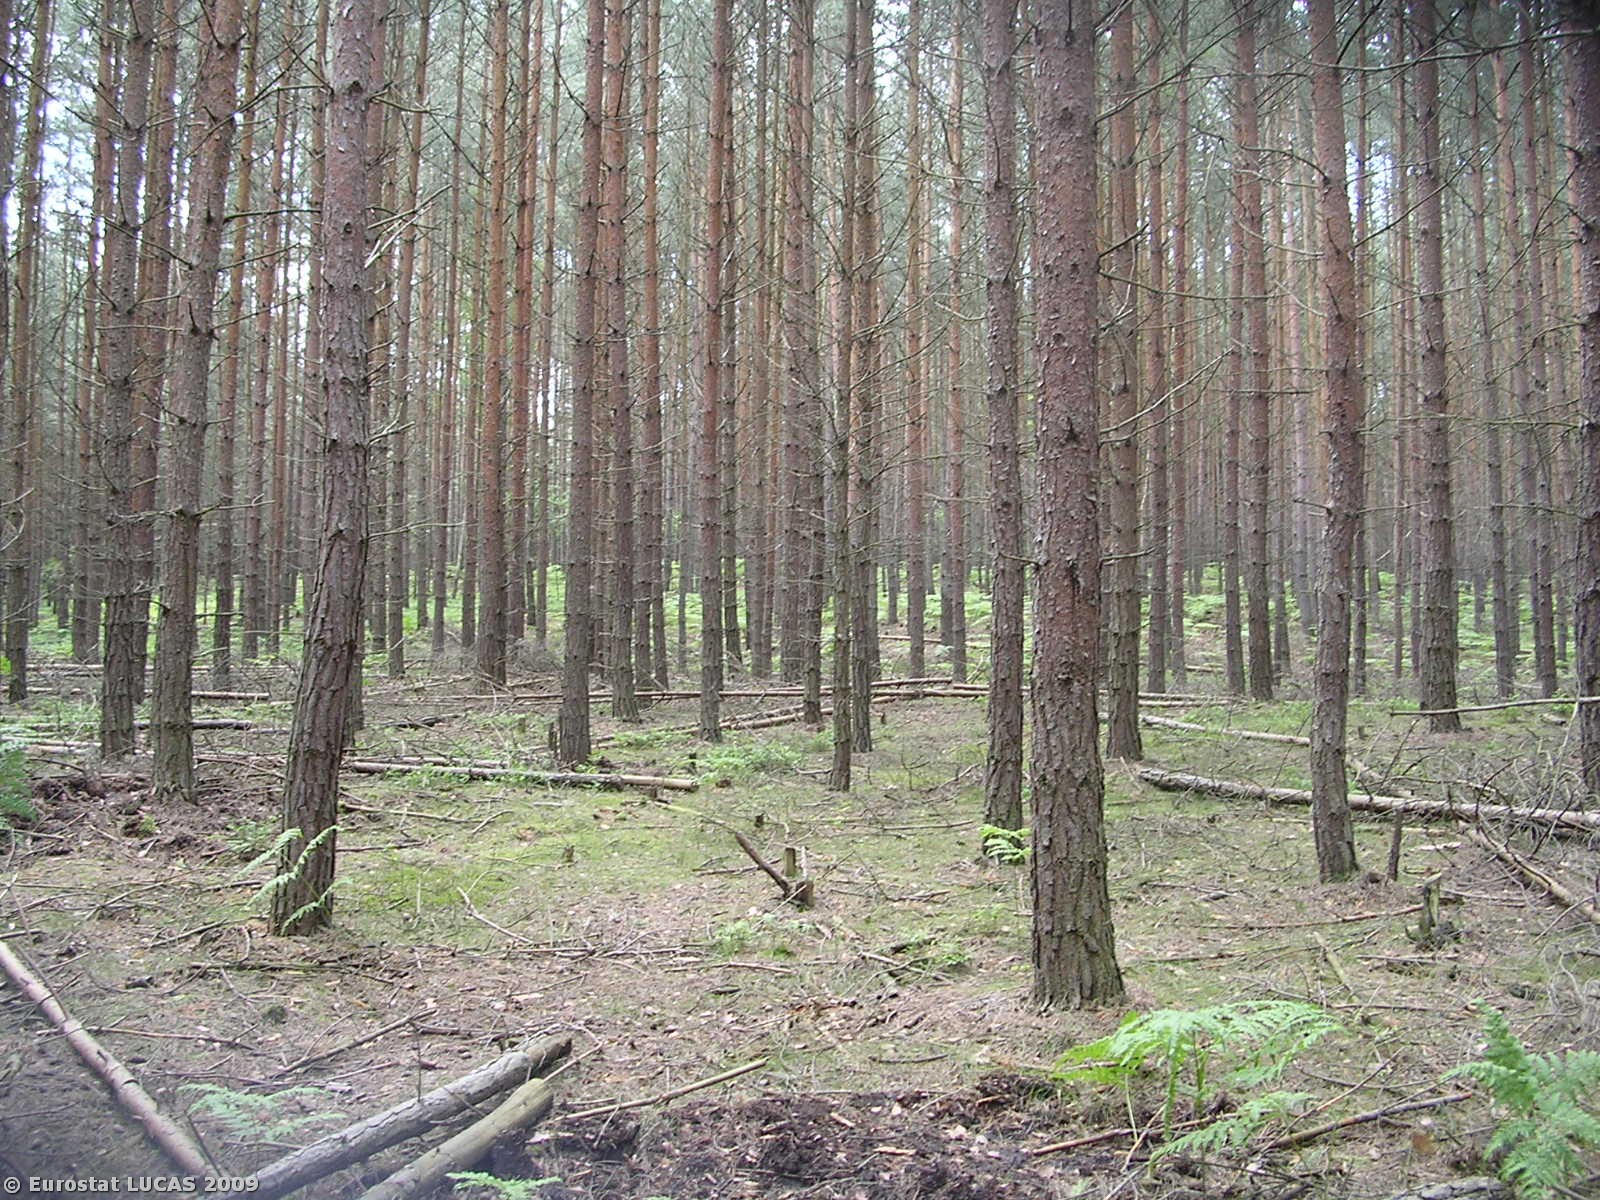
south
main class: Woodland
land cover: Coniferous woodland
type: hemiboreal forest and nemoral coniferous forest and mixed broadleaved-coniferous forest
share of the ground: > 75 %
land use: Forestry
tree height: > 5 m
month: June
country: CZ
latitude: 50.5544
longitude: 14.7307
